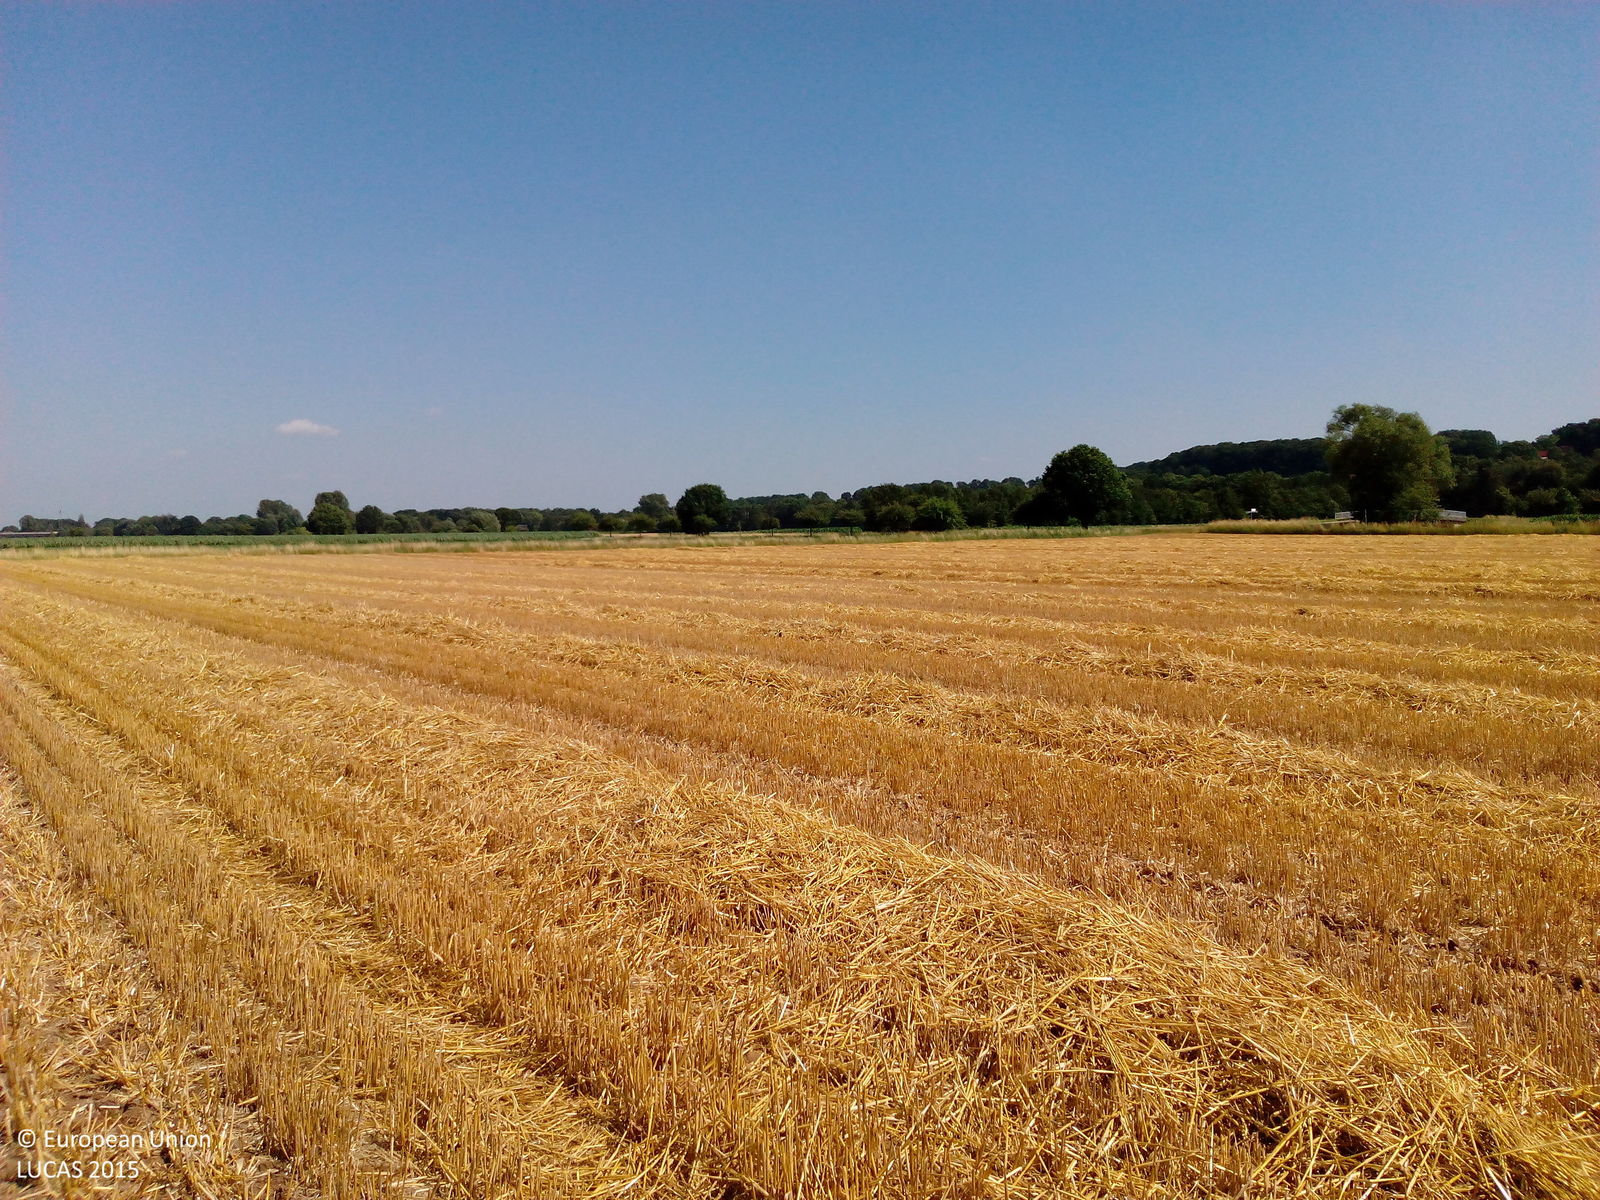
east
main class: Cropland
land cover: Barley
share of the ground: 50 - 75 %
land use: Agriculture (excluding fallow land and kitchen gardens)
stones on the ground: < 10 %
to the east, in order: Barley; Shruby margins; Rivers and streams; Shruby margins; Other fresh vegetables
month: July
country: DE
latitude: 52.3959
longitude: 7.9577
